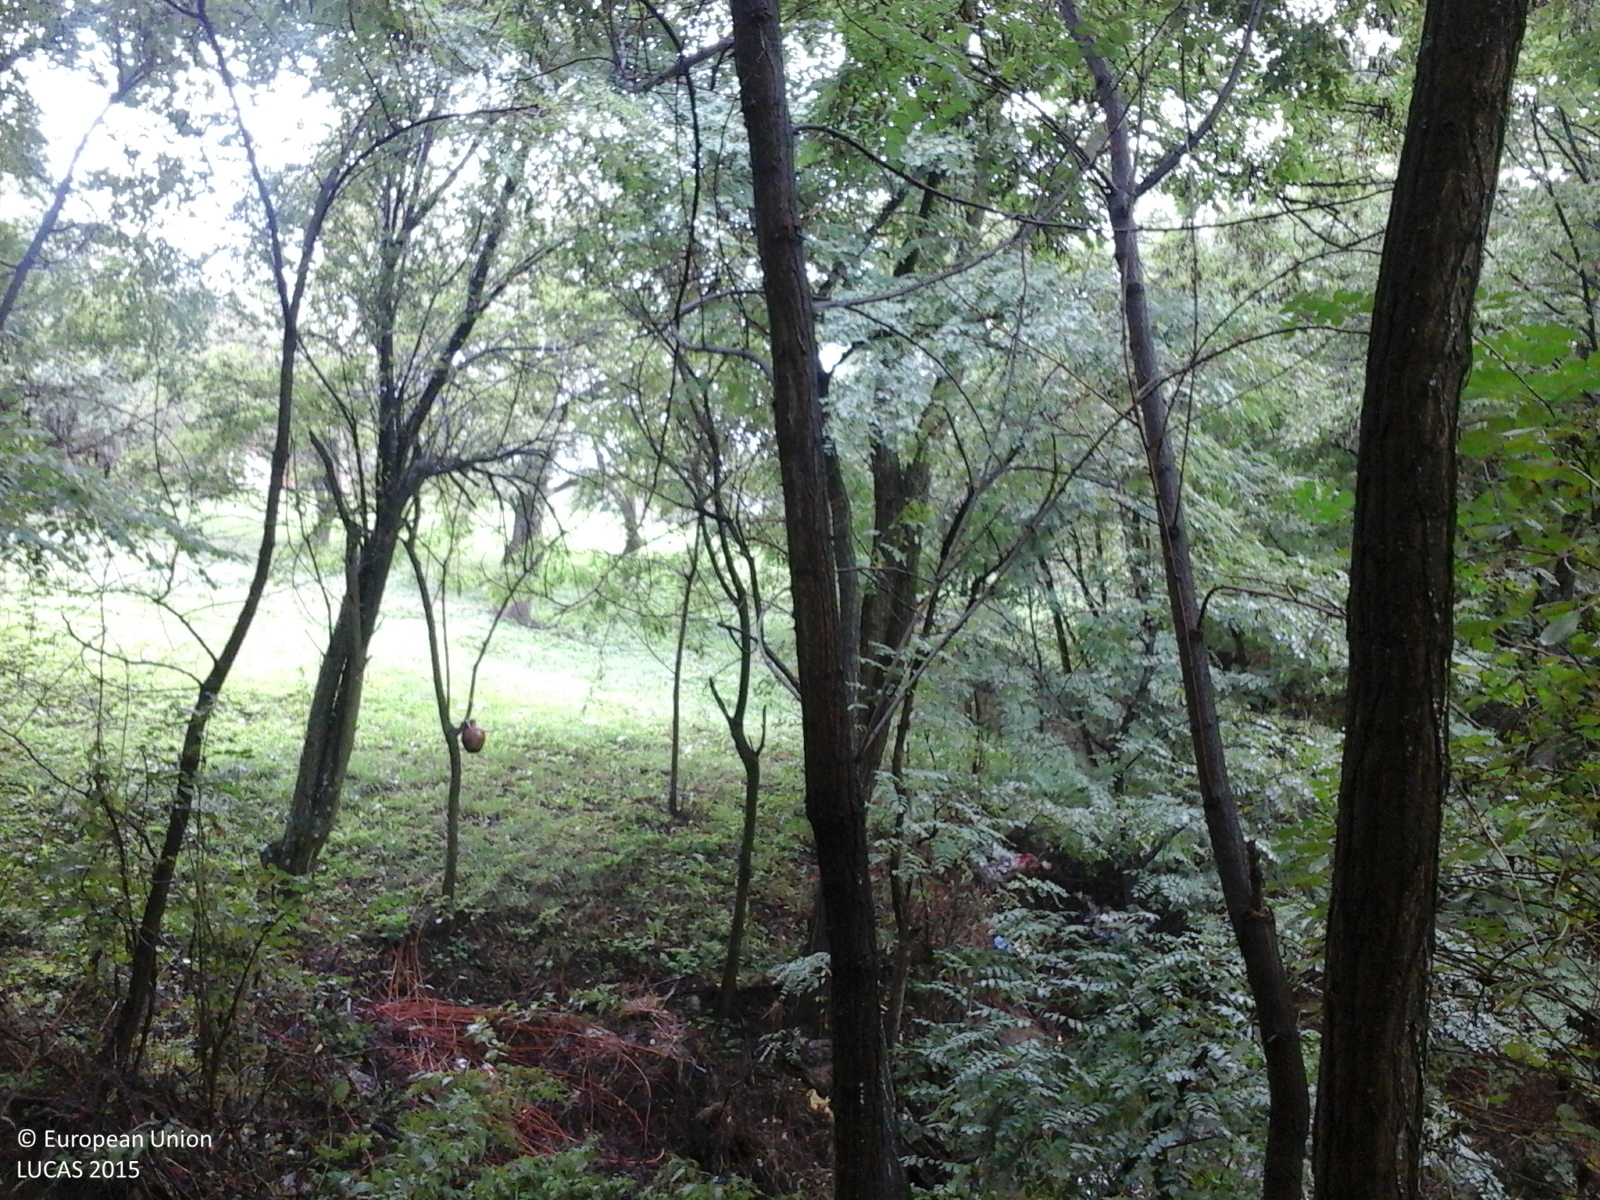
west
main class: Woodland
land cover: Broadleaved woodland
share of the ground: > 75 %
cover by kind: broadleaved forest trees 100 %
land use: Forestry
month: September
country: RO
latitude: 45.1571
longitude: 24.4890
